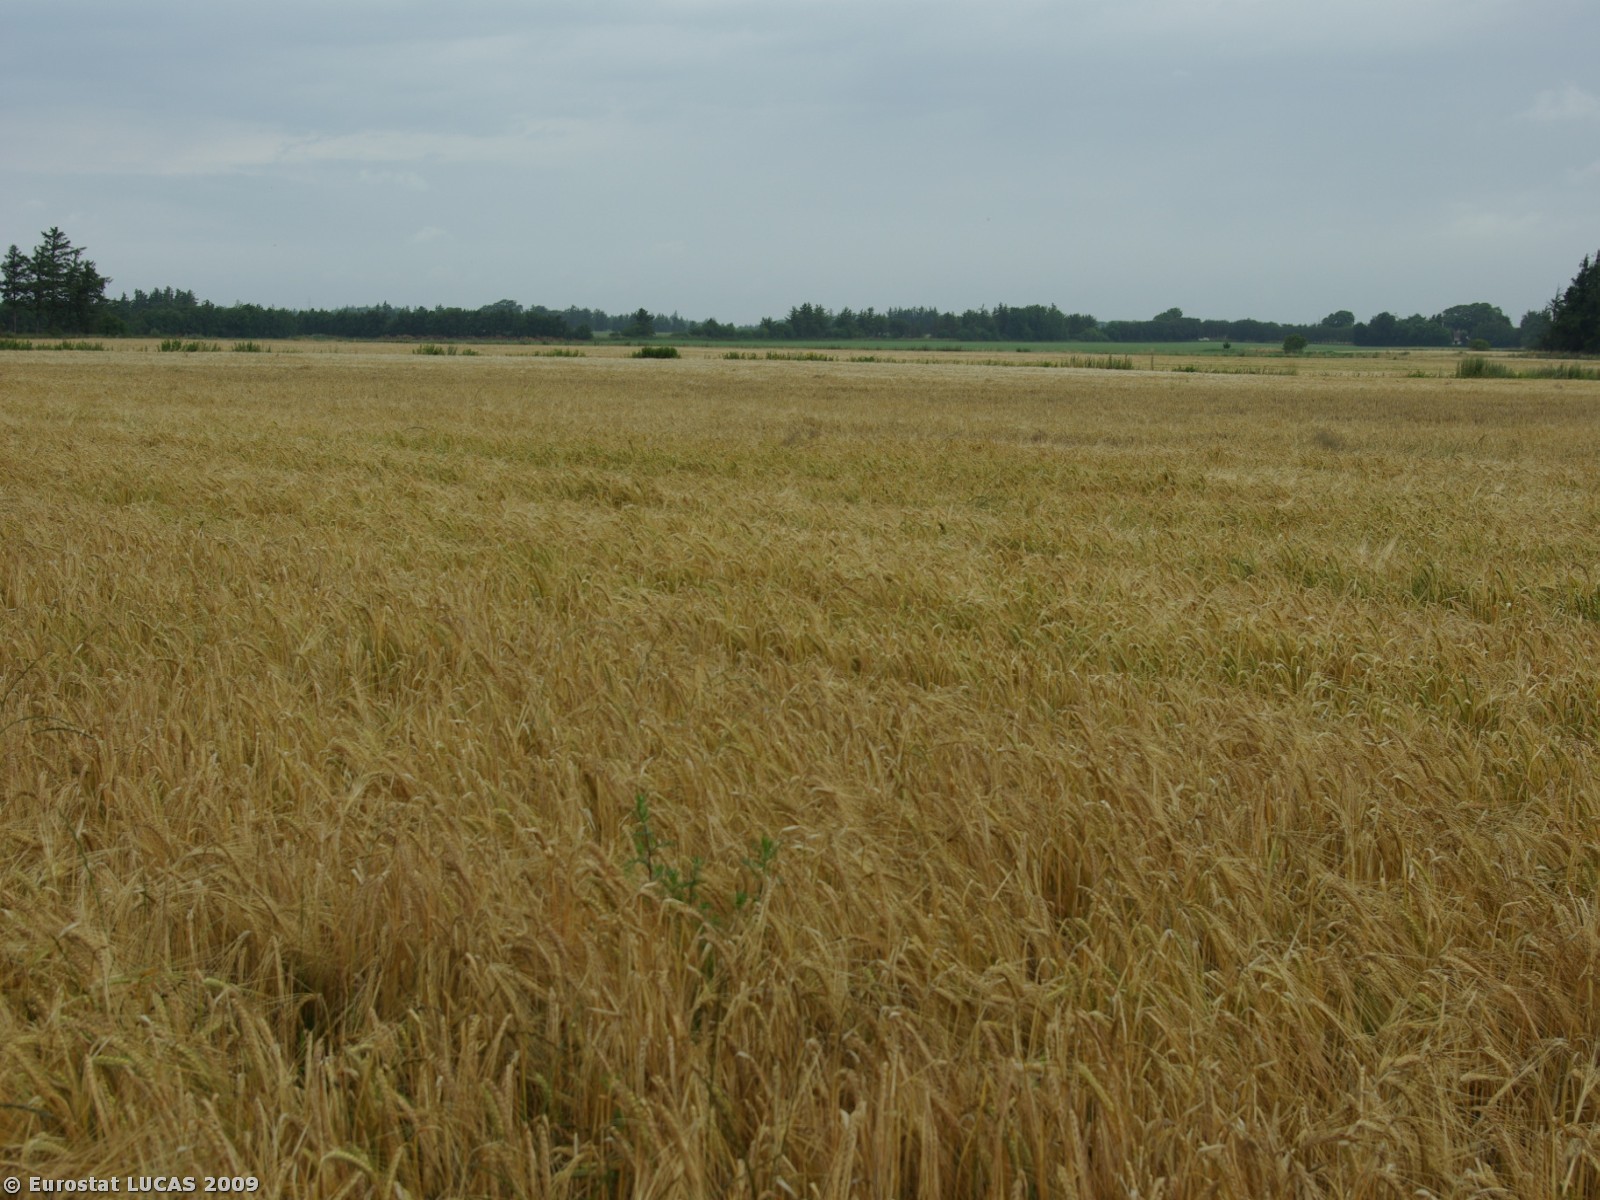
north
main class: Cropland
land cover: Barley
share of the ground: > 75 %
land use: Agriculture (excluding fallow land and kitchen gardens)
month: July
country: DK
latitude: 55.2835
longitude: 8.8202
